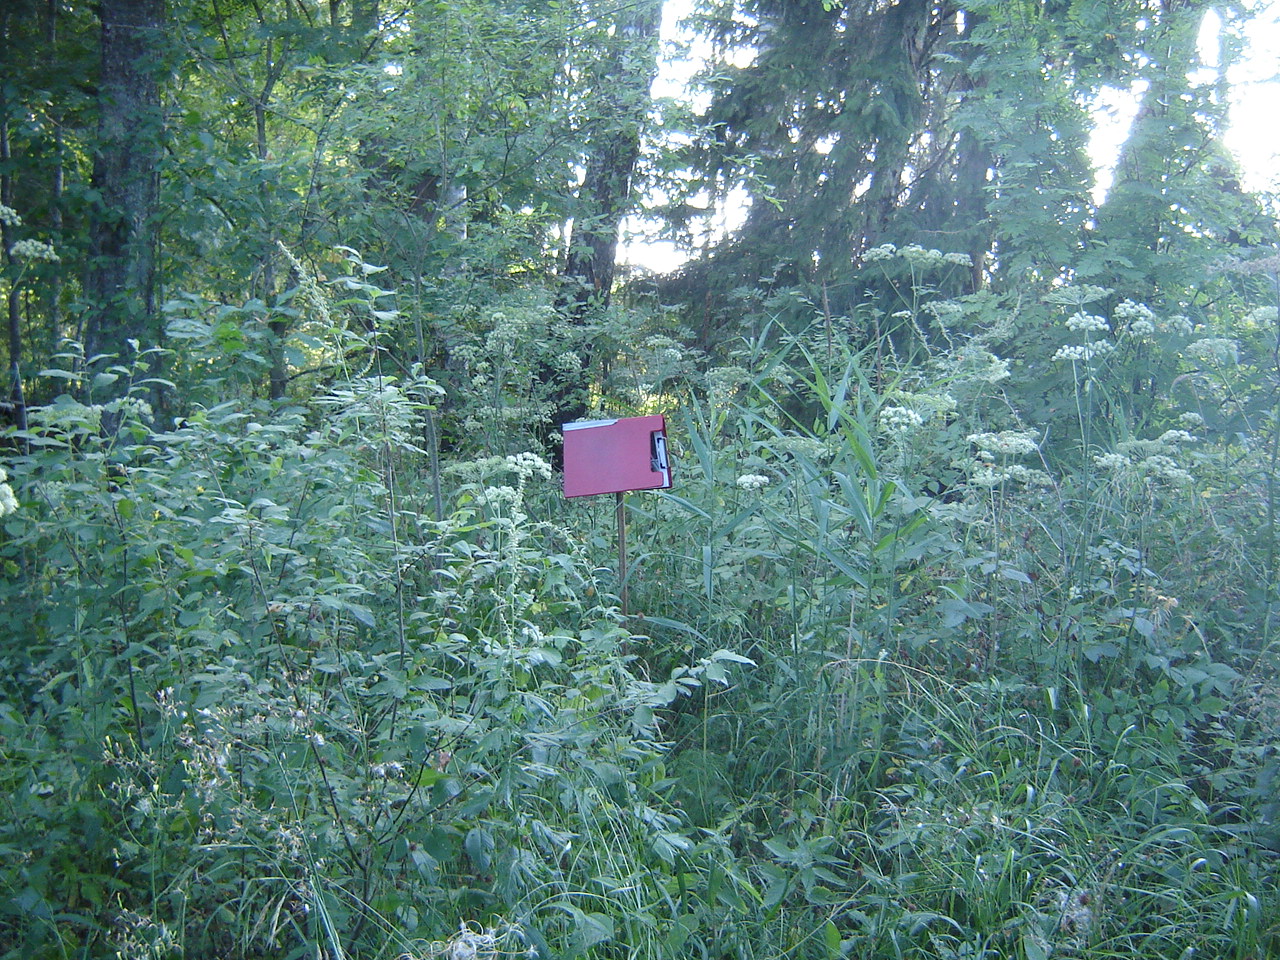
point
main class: Woodland
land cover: Other mixed woodland
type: hemiboreal forest and nemoral coniferous forest and mixed broadleaved-coniferous forest
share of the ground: > 75 %
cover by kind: broadleaved forest trees 55 %, coniferous forest trees 30 %, herbaceous plants 10 %, shrubs 5 %
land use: Forestry
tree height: > 5 m
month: August
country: LT
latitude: 54.9763
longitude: 24.9390
